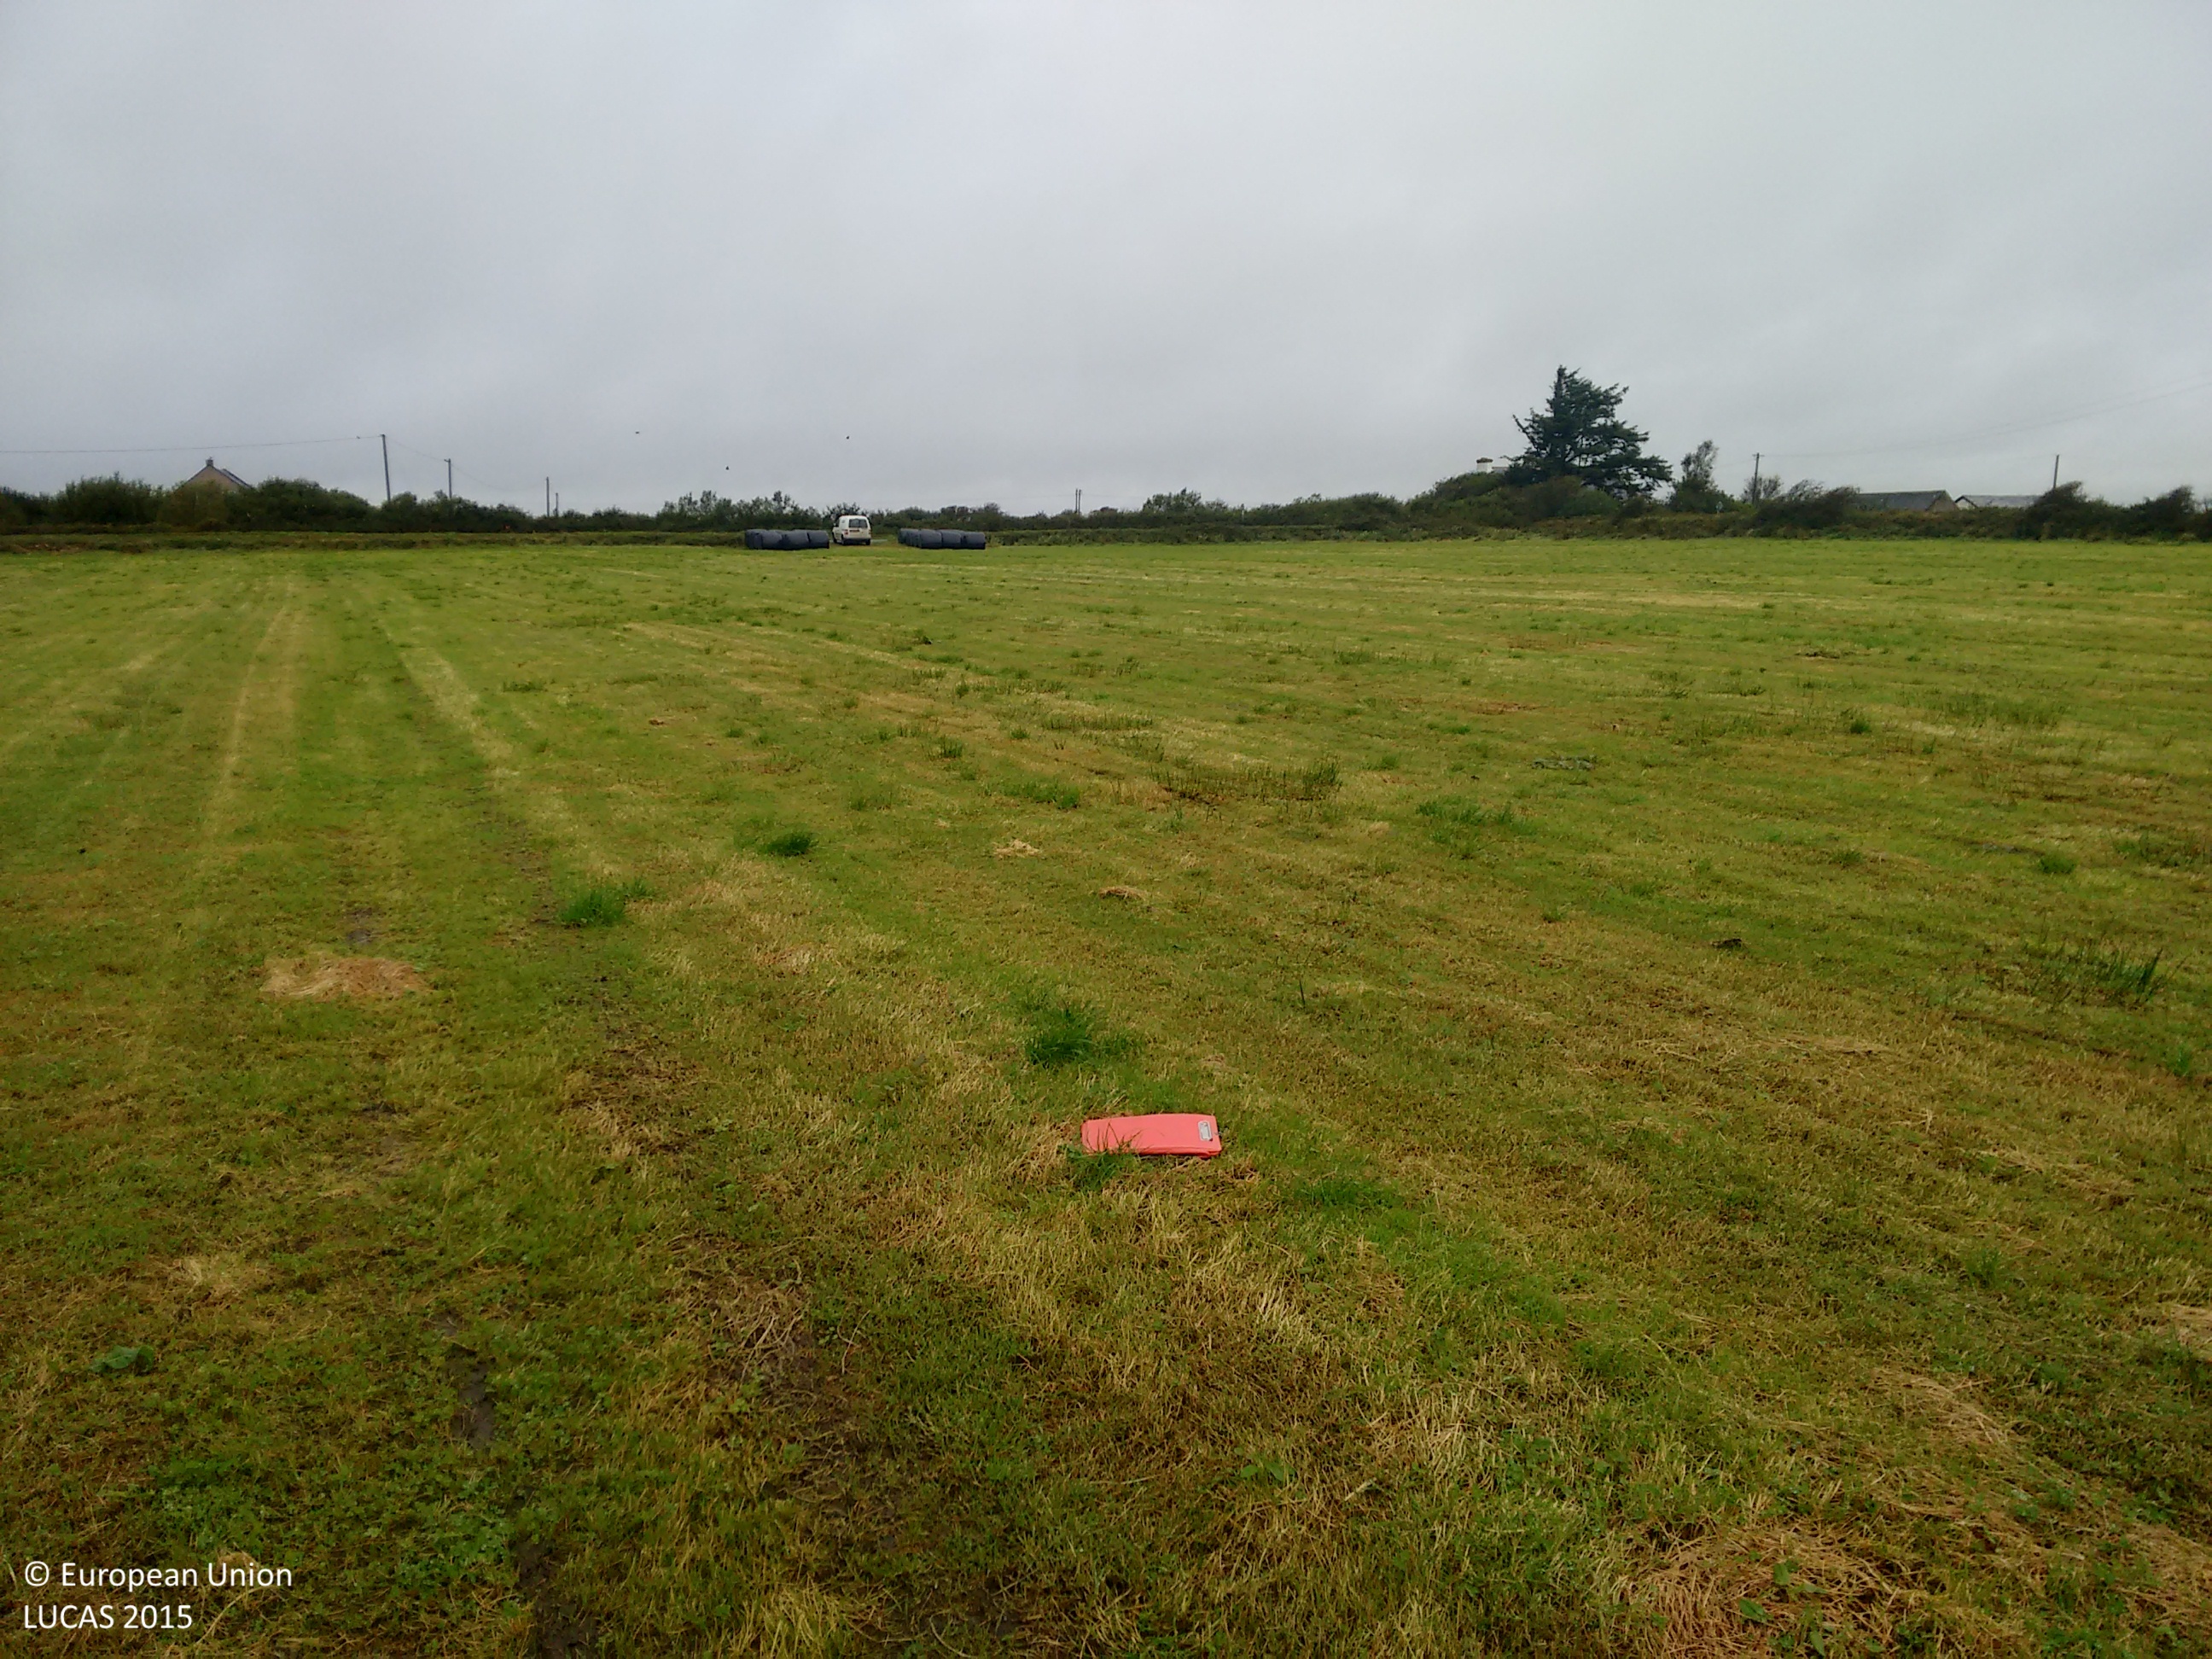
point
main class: Grassland
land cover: Grassland without tree/shrub cover
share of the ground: > 75 %
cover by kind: herbaceous plants 95 %, unconsolidated bare surface 5 %
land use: Agriculture (excluding fallow land and kitchen gardens)
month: September
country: IE
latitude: 52.6717
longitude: -9.5644
